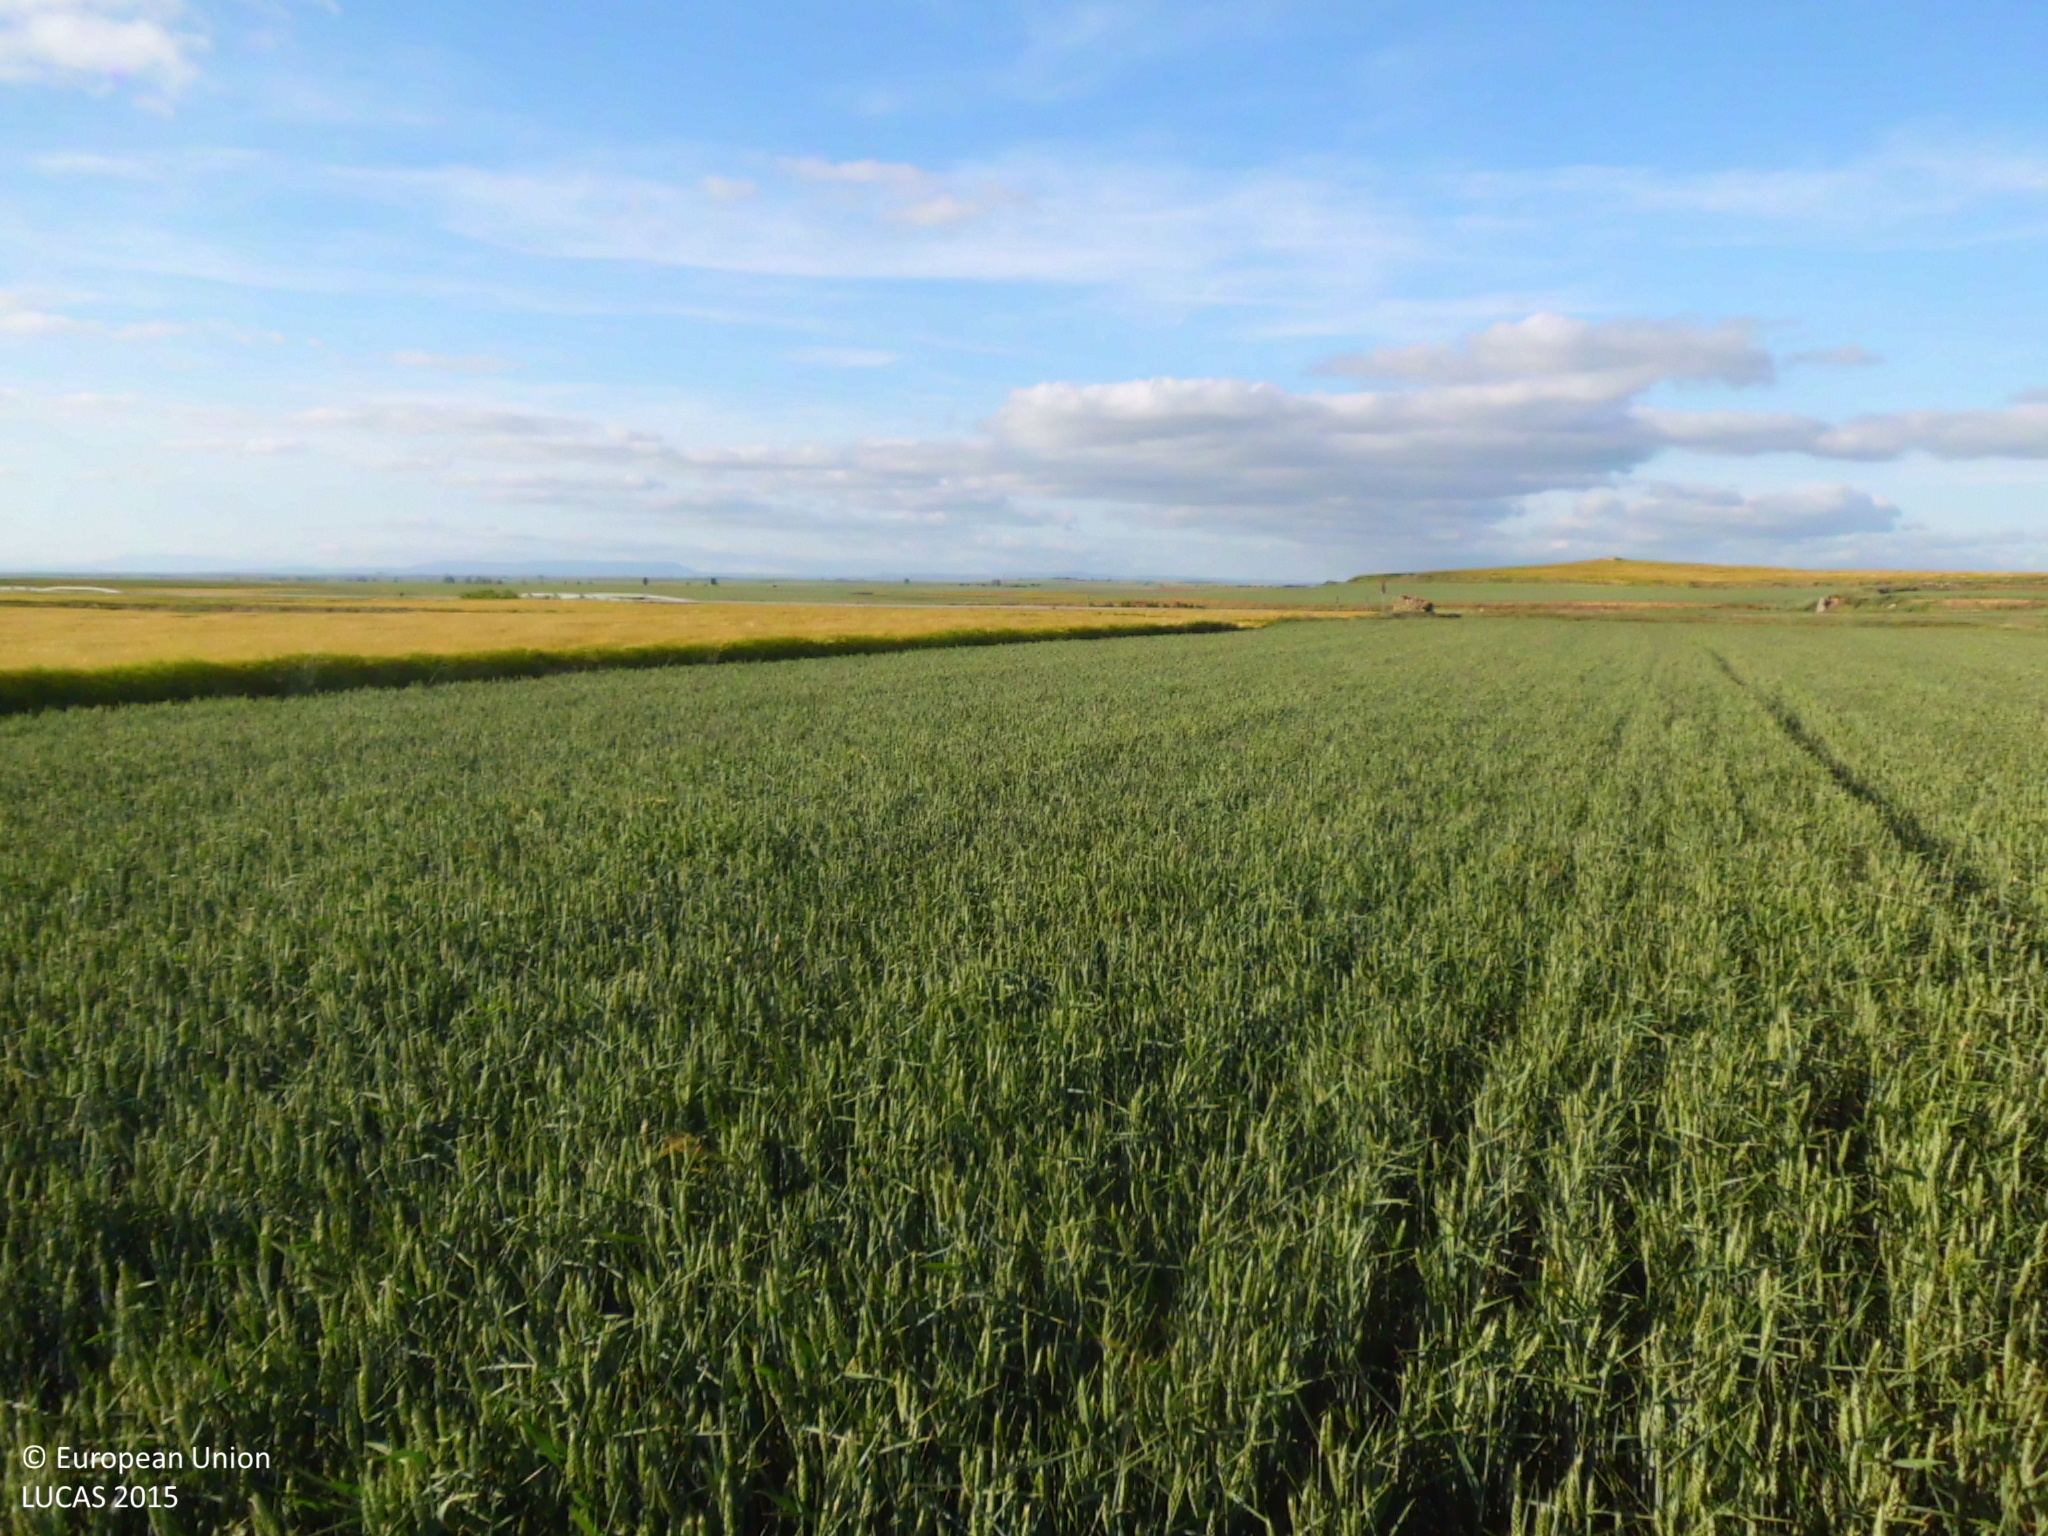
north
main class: Cropland
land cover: Common wheat
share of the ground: > 75 %
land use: Agriculture (excluding fallow land and kitchen gardens)
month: May
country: ES
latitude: 42.3101
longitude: -4.1771
